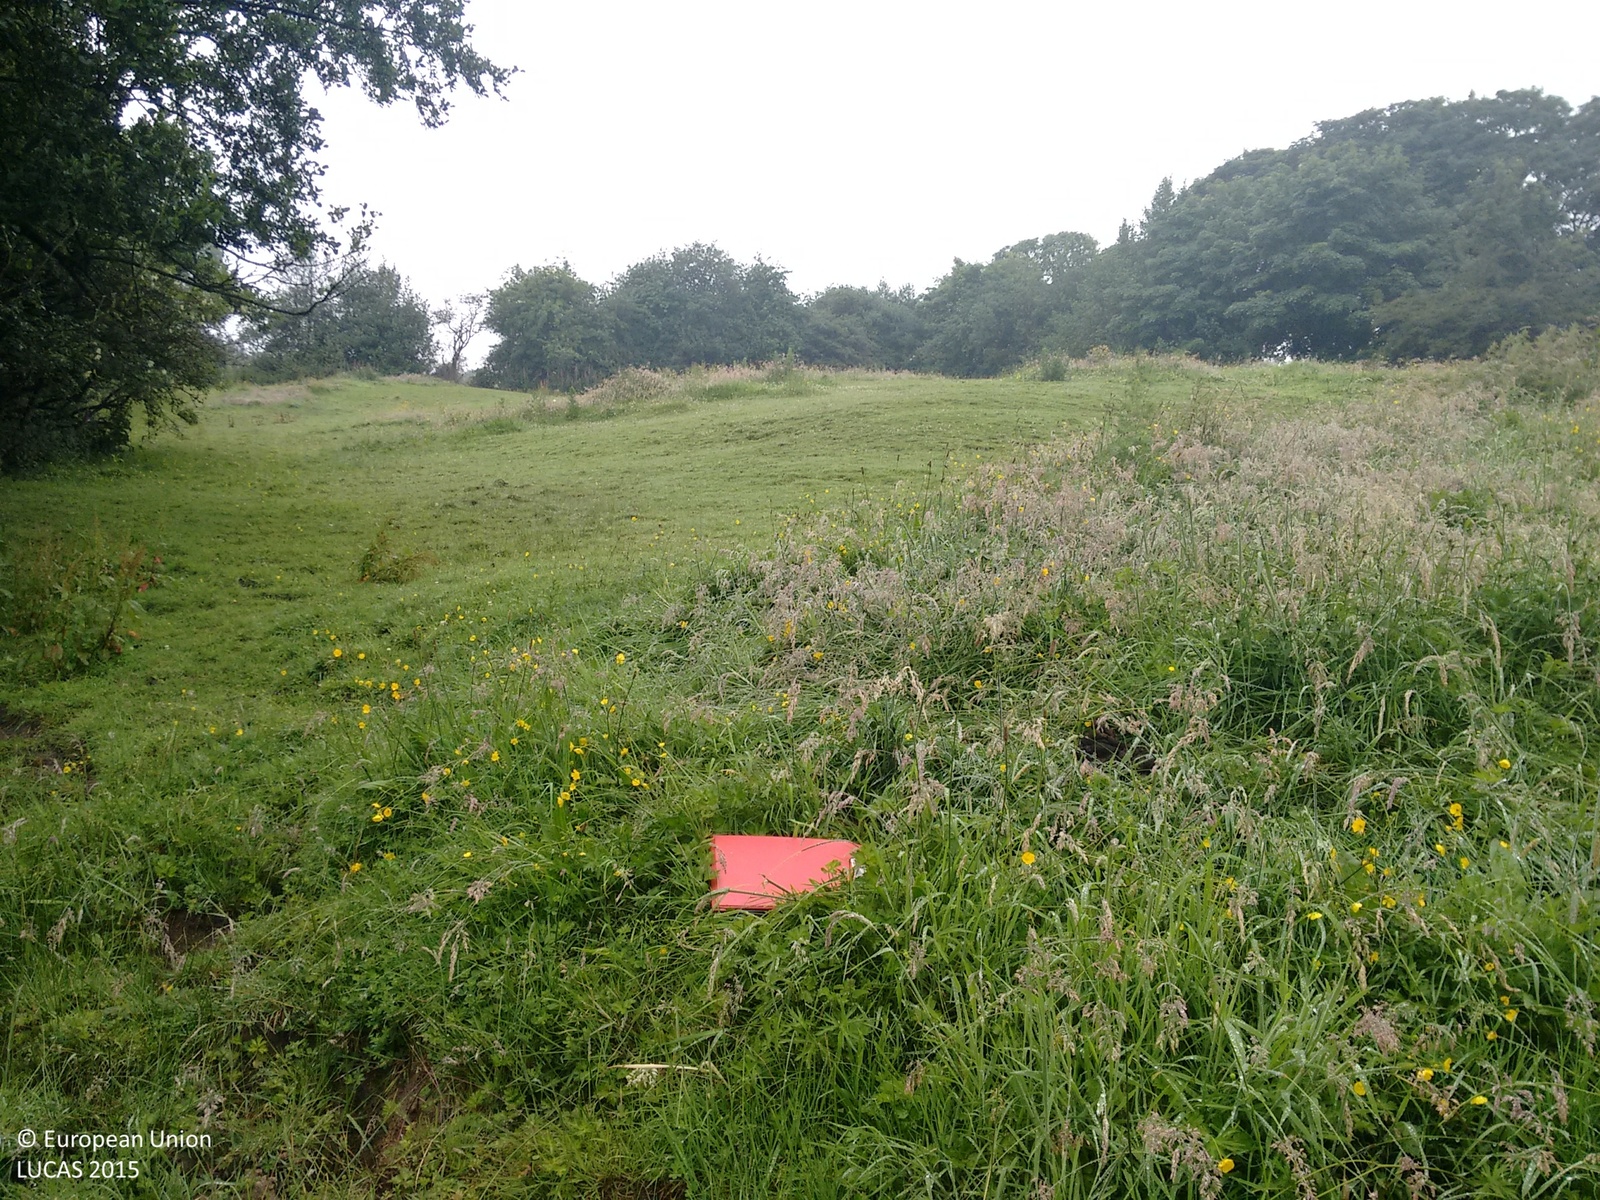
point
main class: Grassland
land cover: Grassland without tree/shrub cover
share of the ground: > 75 %
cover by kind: herbaceous plants 100 %
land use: Agriculture (excluding fallow land and kitchen gardens)
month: July
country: GB
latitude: 53.1447
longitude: -2.0338
